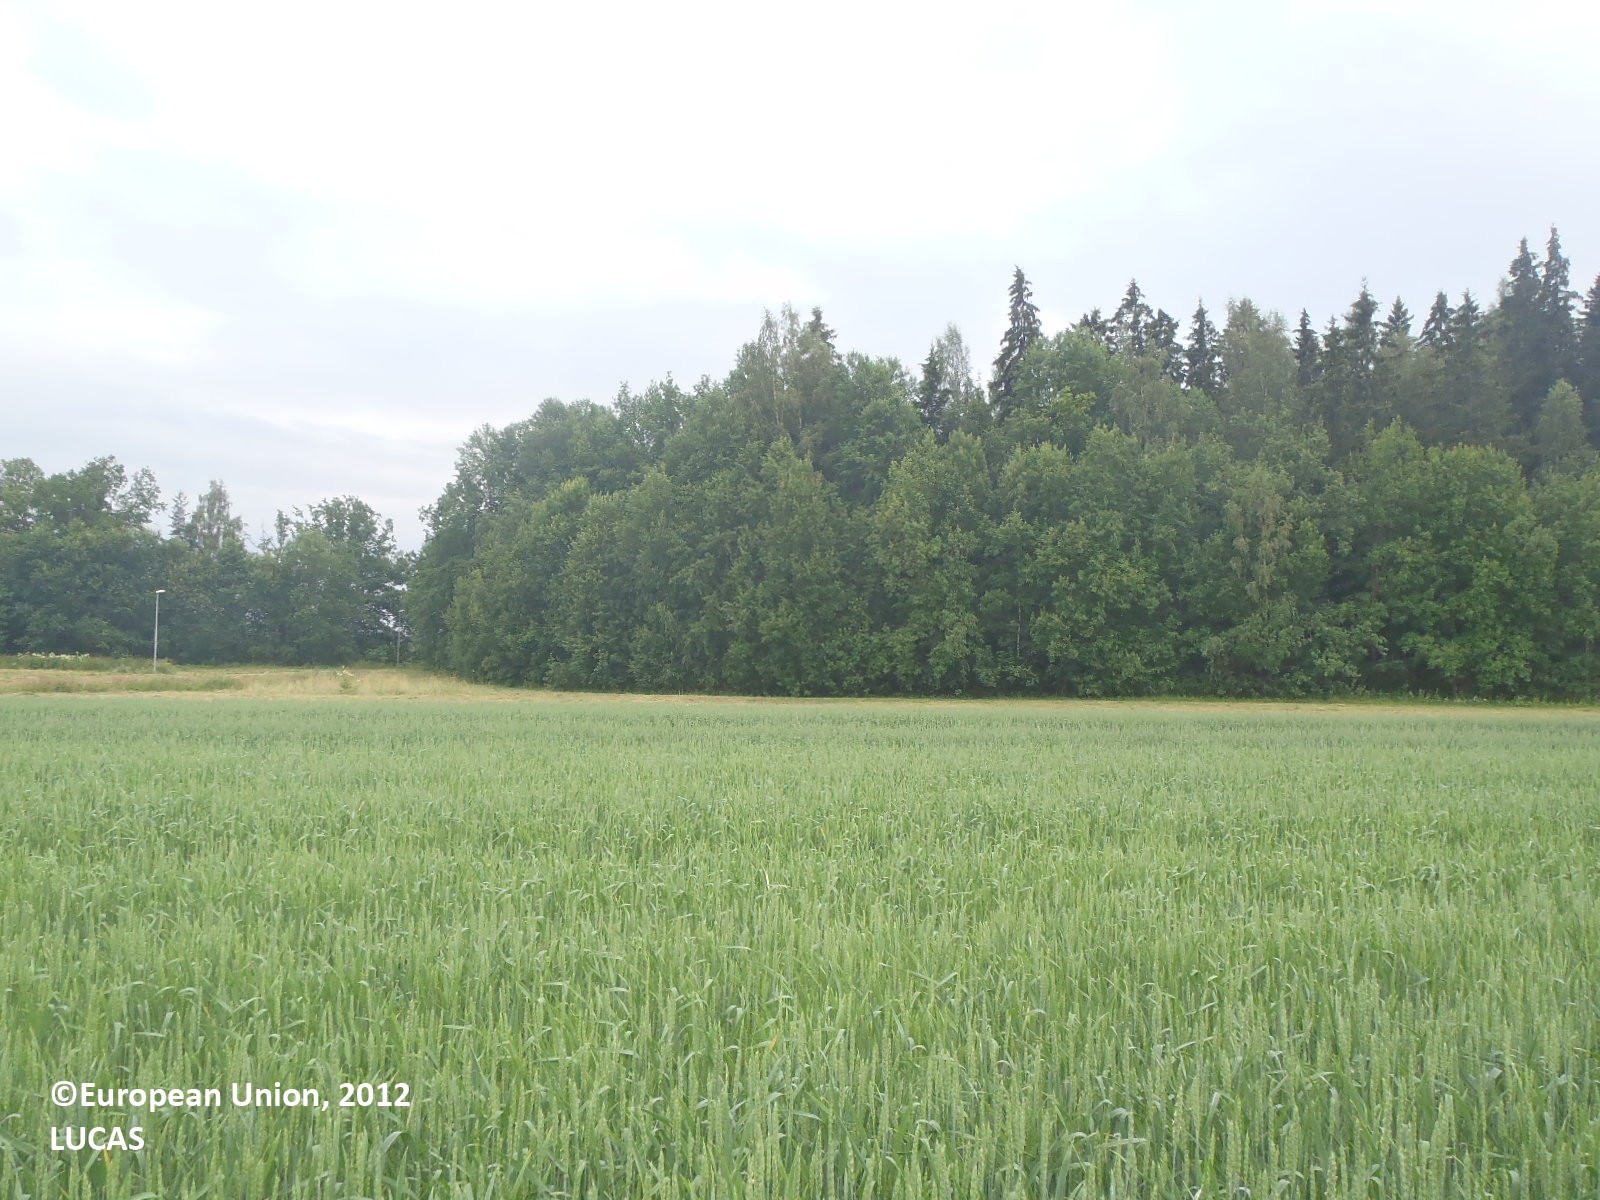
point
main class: Cropland
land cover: Common wheat
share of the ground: > 75 %
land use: Agriculture (excluding fallow land and kitchen gardens)
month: July
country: FI
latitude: 60.4109
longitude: 22.2496
